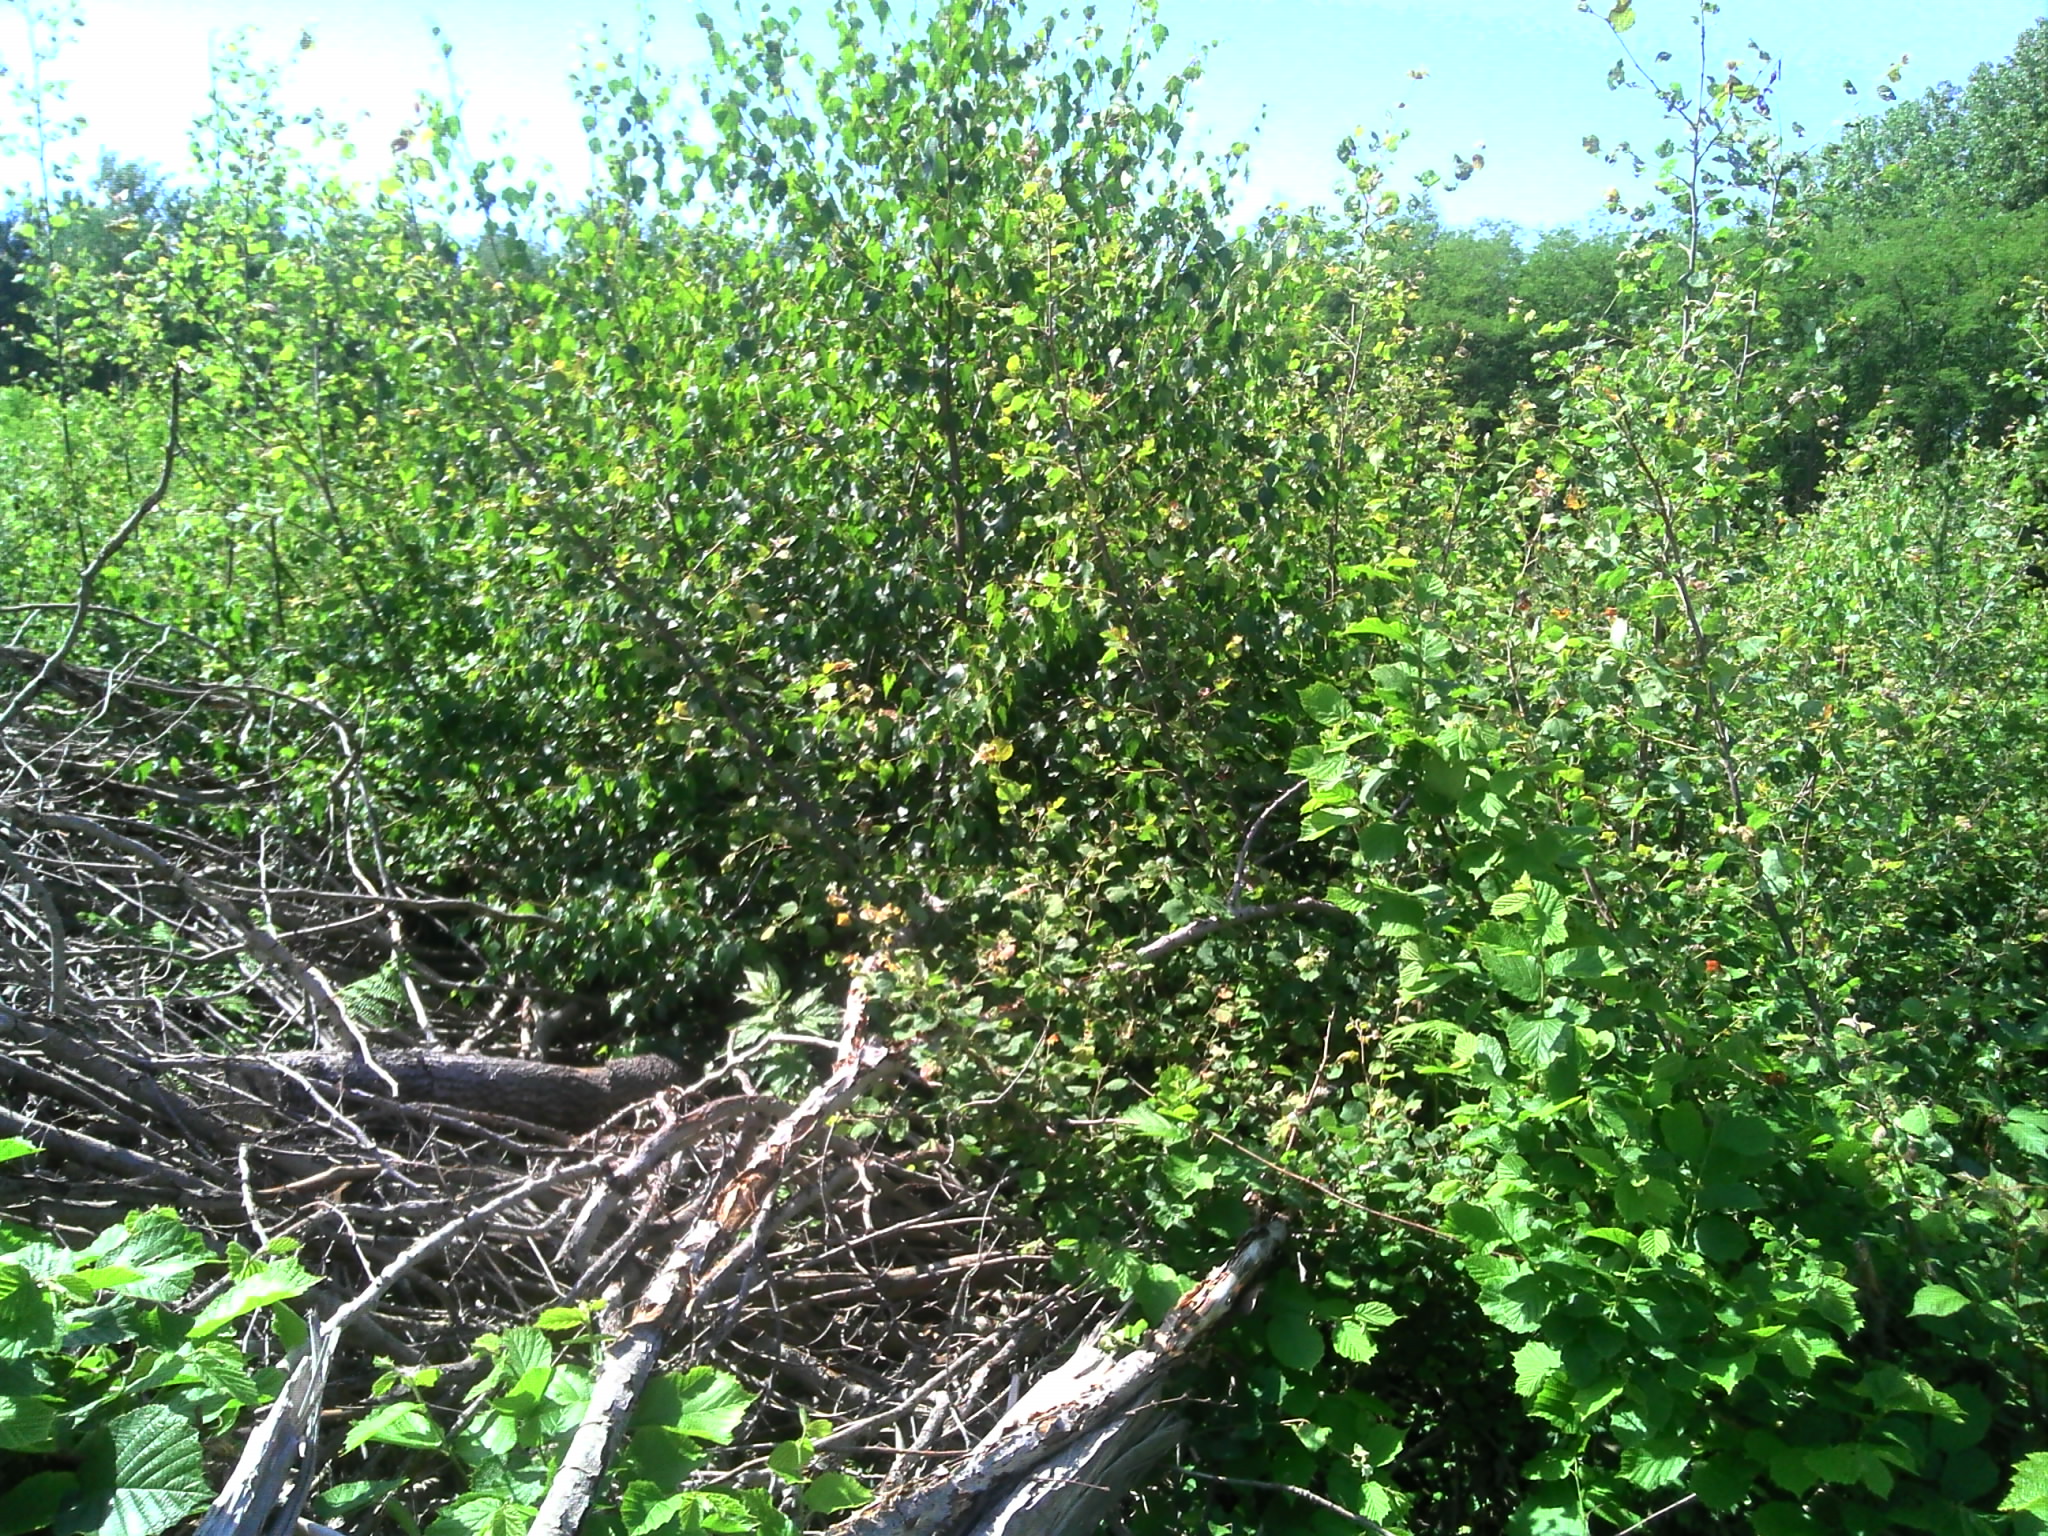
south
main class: Woodland
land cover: Broadleaved woodland
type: mesophytic deciduous forest
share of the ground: > 75 %
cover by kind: broadleaved forest trees 65 %, herbaceous plants 35 %
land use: Forestry
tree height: < 5 m
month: May
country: FR
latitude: 46.5965
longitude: 5.0286
